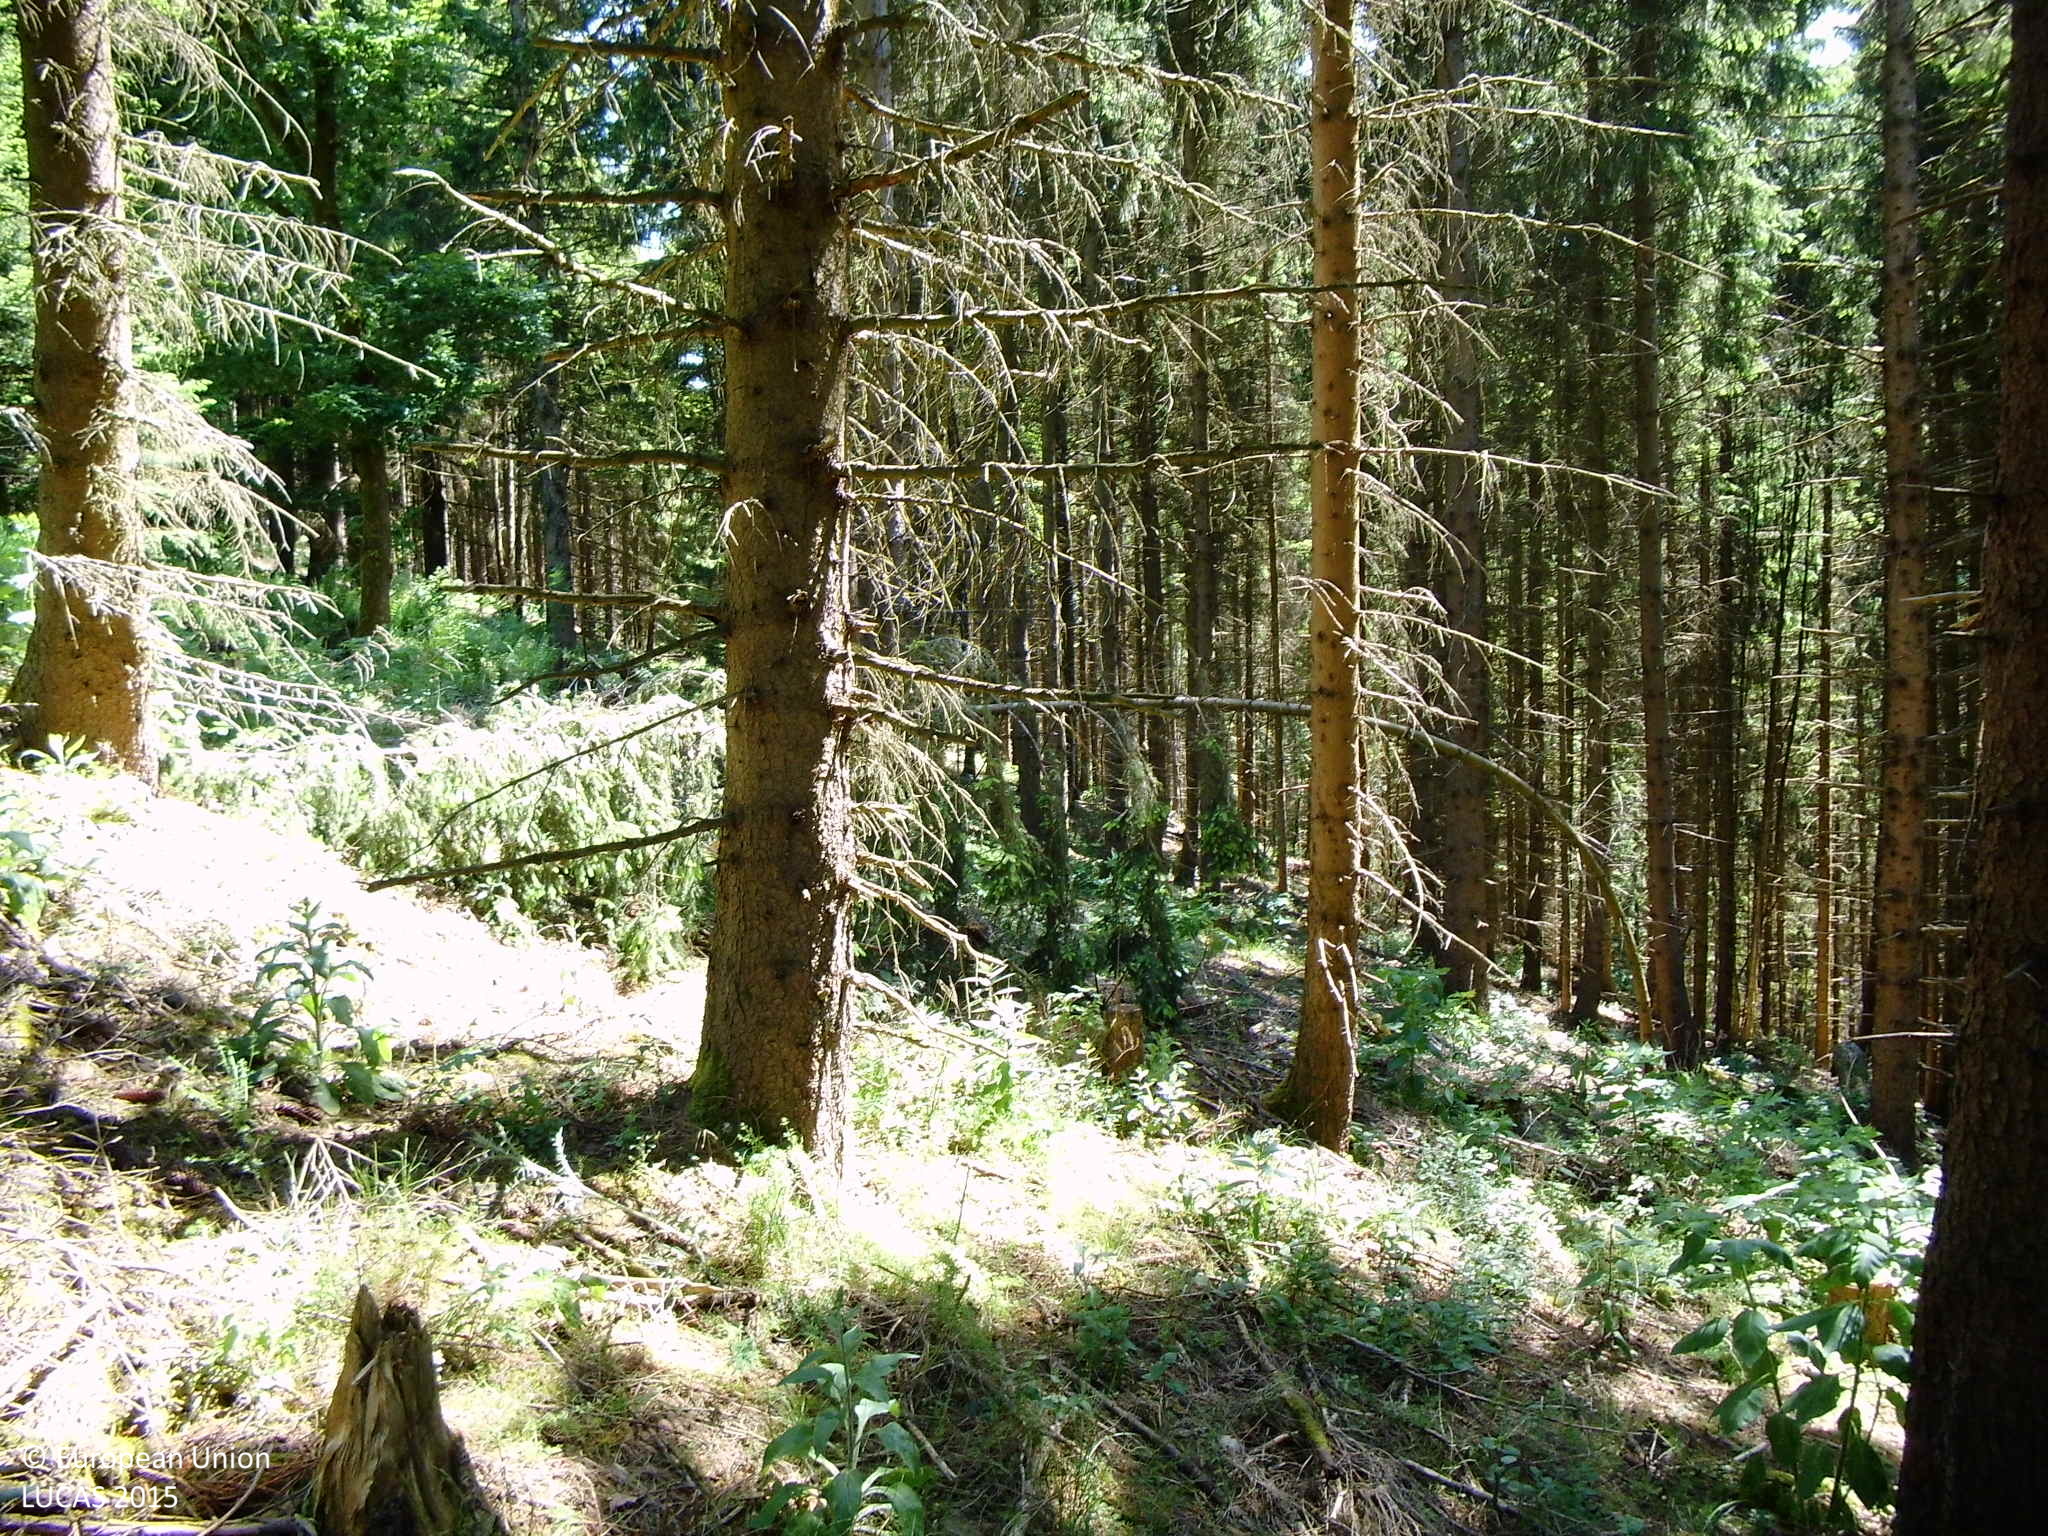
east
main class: Woodland
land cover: Spruce dominated coniferous woodland
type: hemiboreal forest and nemoral coniferous forest and mixed broadleaved-coniferous forest
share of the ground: > 75 %
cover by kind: coniferous forest trees 75 %, broadleaved forest trees 10 %, herbaceous plants 10 %, lichens and mosses 5 %
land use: Forestry
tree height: > 5 m
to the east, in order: Spruce dominated coniferous woodland; Spontaneously vegetated surfaces; Spruce dominated coniferous woodland; Tracks; Spruce dominated mixed woodland
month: June
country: DE
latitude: 50.9290
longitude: 8.4495
